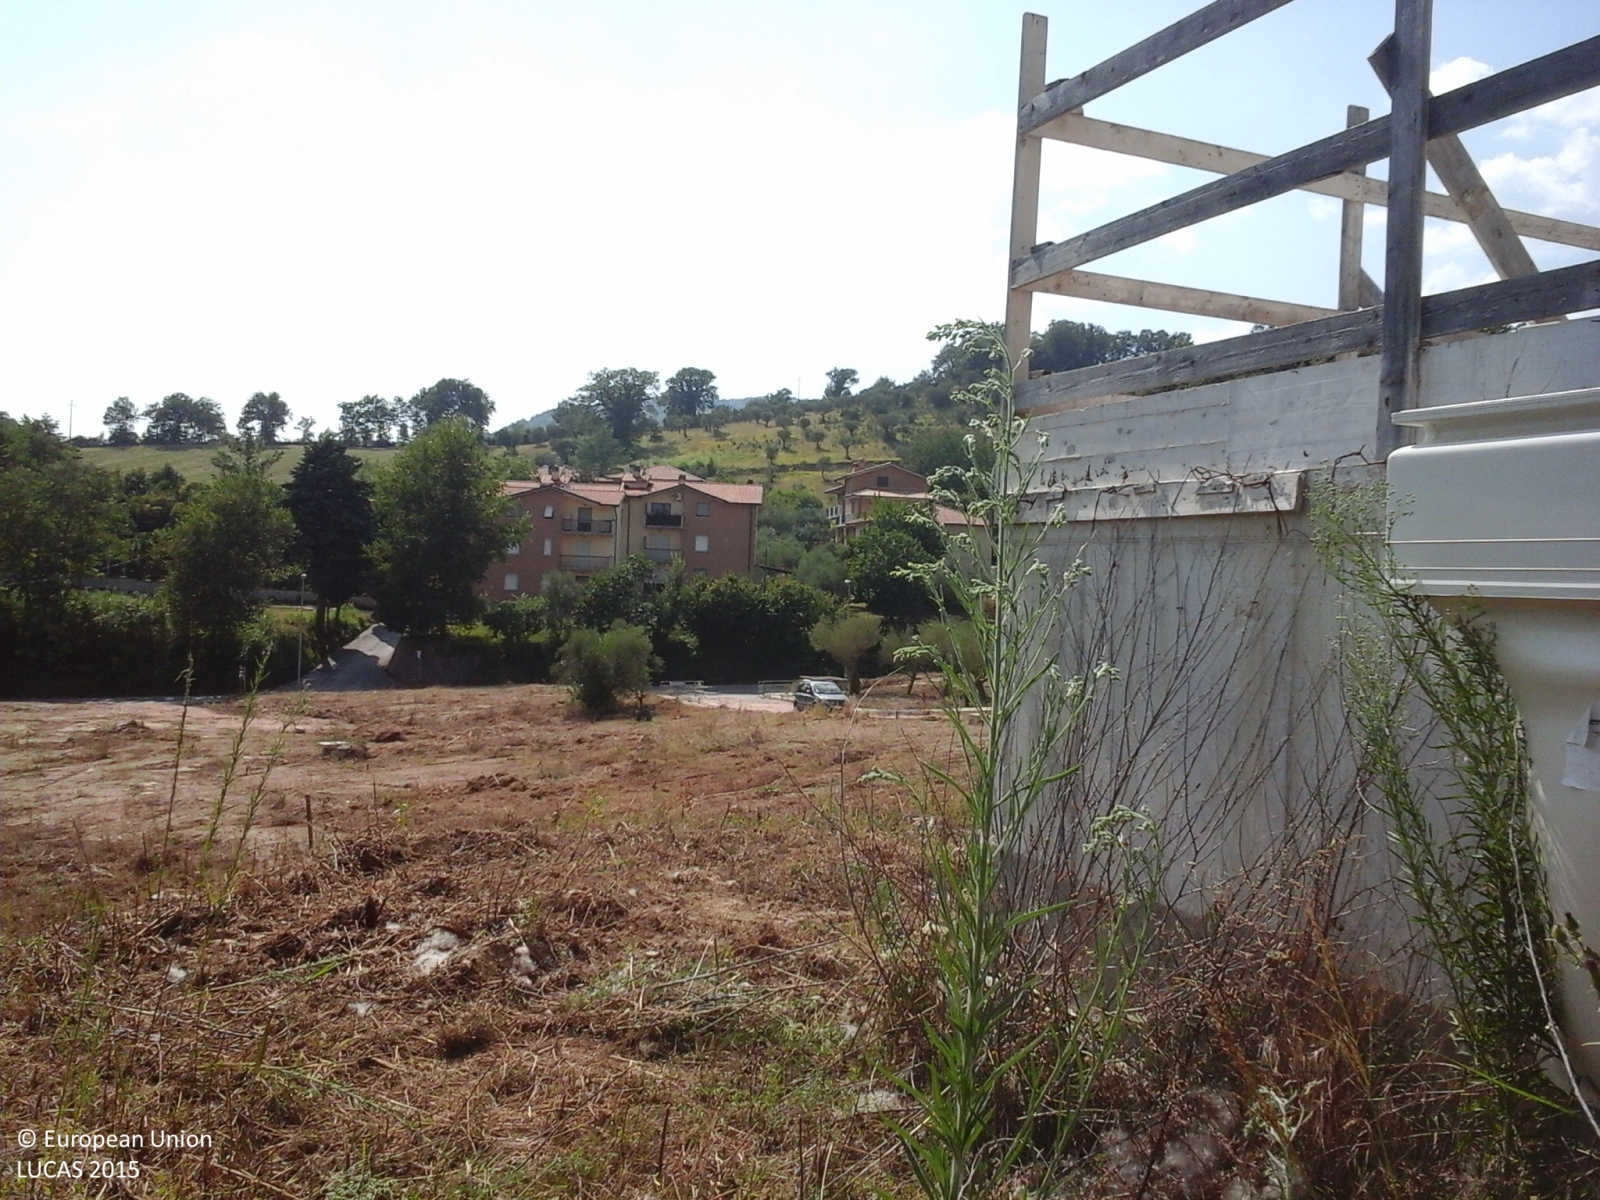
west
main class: Grassland
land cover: Spontaneously vegetated surfaces
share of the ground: > 75 %
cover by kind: herbaceous plants 95 %, shrubs 5 %
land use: Fallow land
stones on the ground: 10 - 25 %
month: August
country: IT
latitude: 43.2365
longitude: 13.1809
